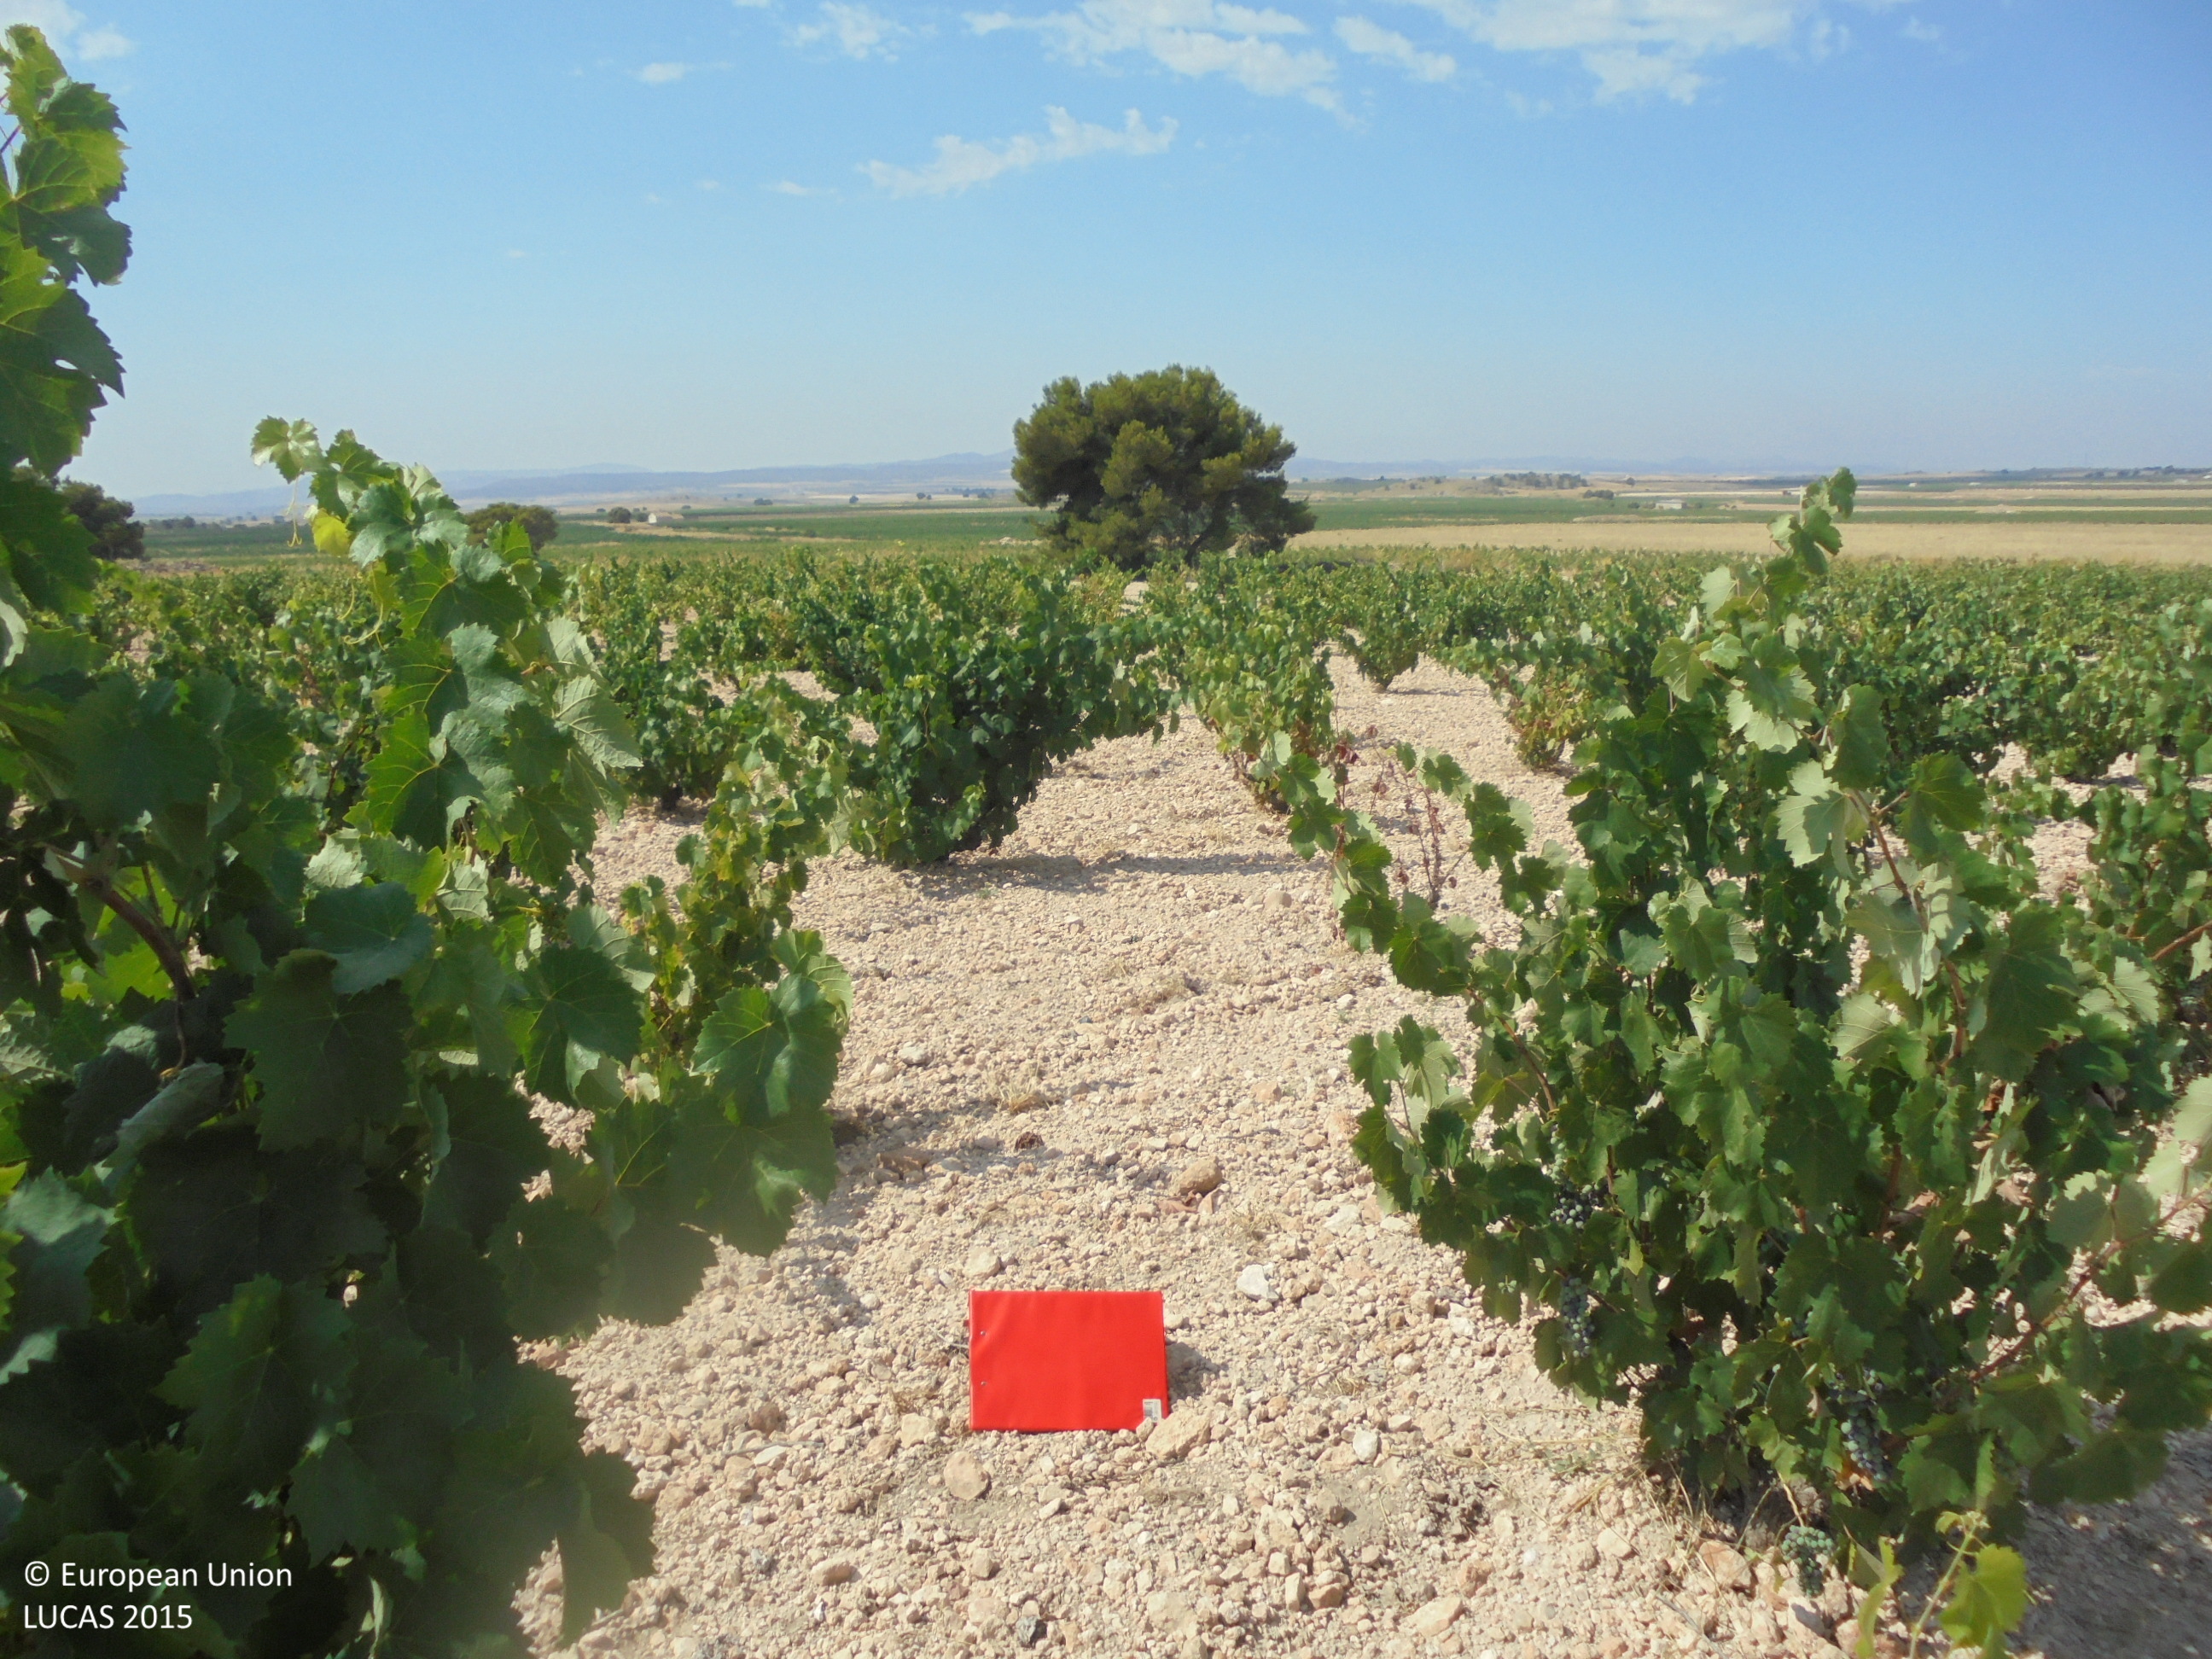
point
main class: Cropland
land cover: Vineyards
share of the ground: 10 - 25 %
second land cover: Other bare soil
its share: > 75 %
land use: Agriculture (excluding fallow land and kitchen gardens)
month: July
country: ES
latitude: 38.6324
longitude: -1.4001
